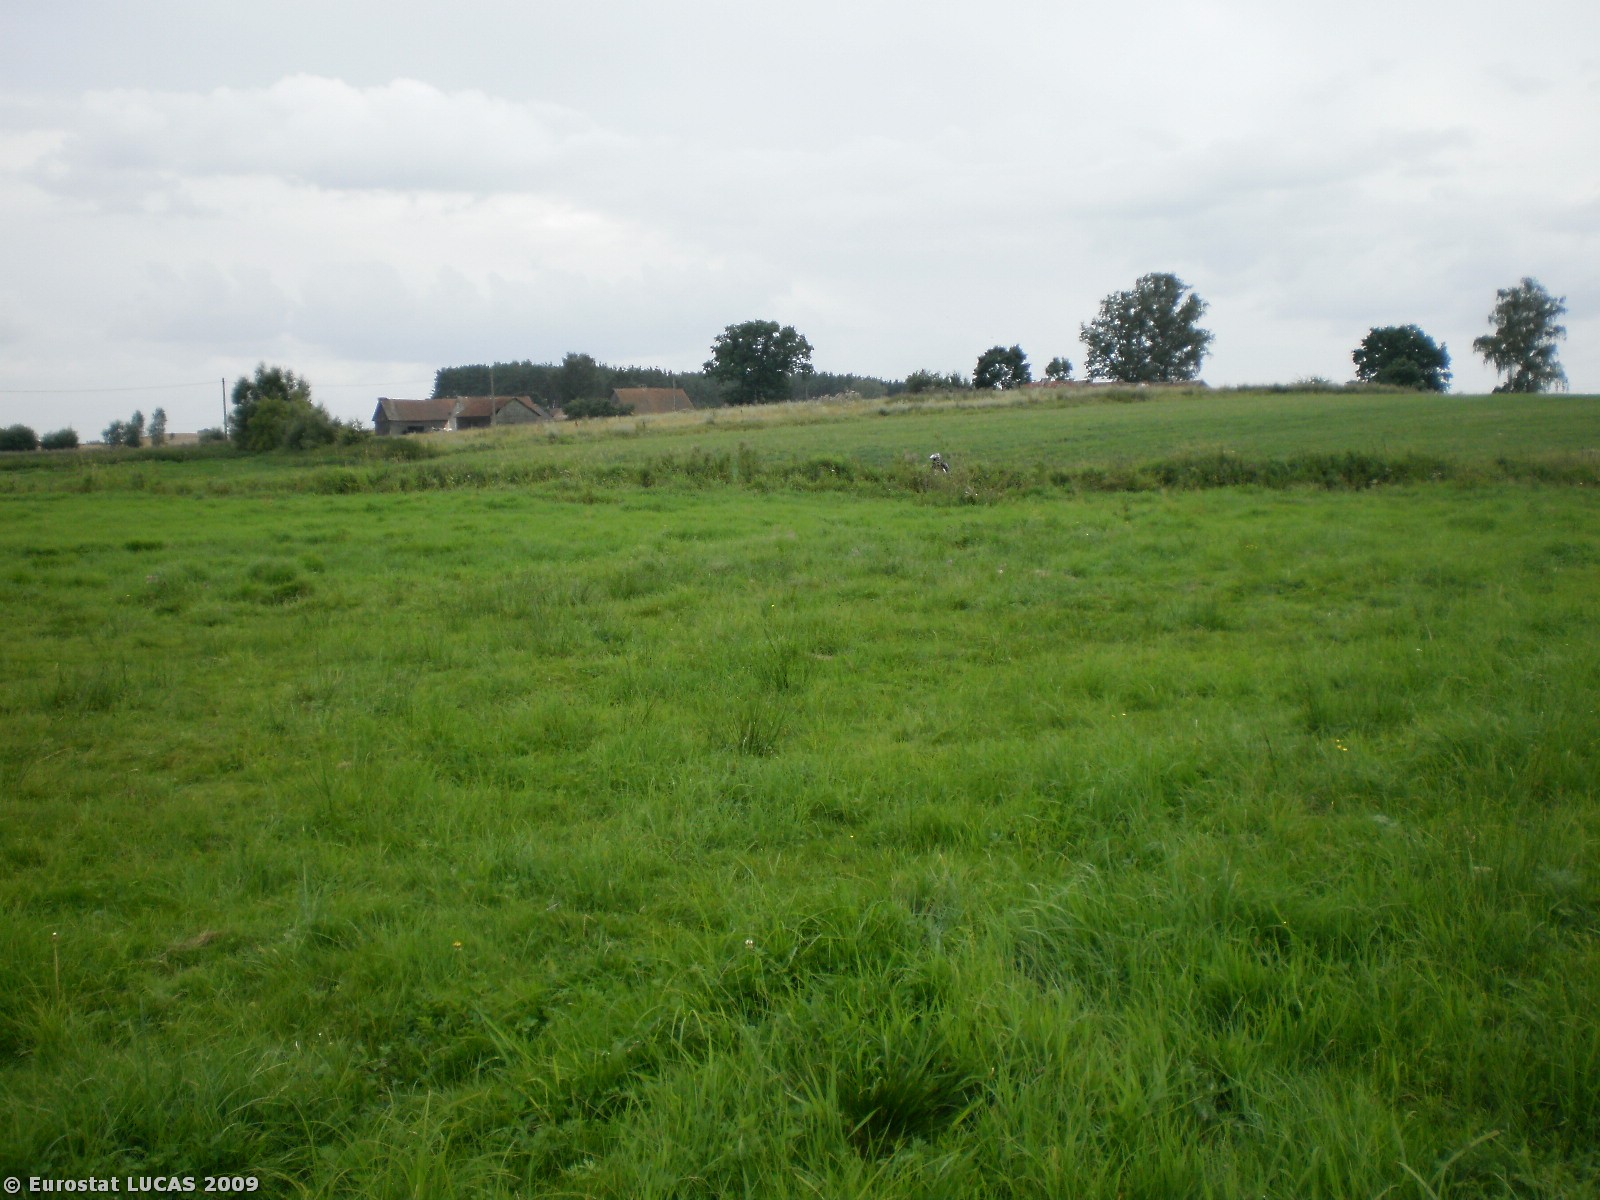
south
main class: Grassland
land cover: Grassland without tree/shrub cover
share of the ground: > 75 %
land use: Agriculture (excluding fallow land and kitchen gardens)
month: August
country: PL
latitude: 54.0933
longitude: 20.6339
